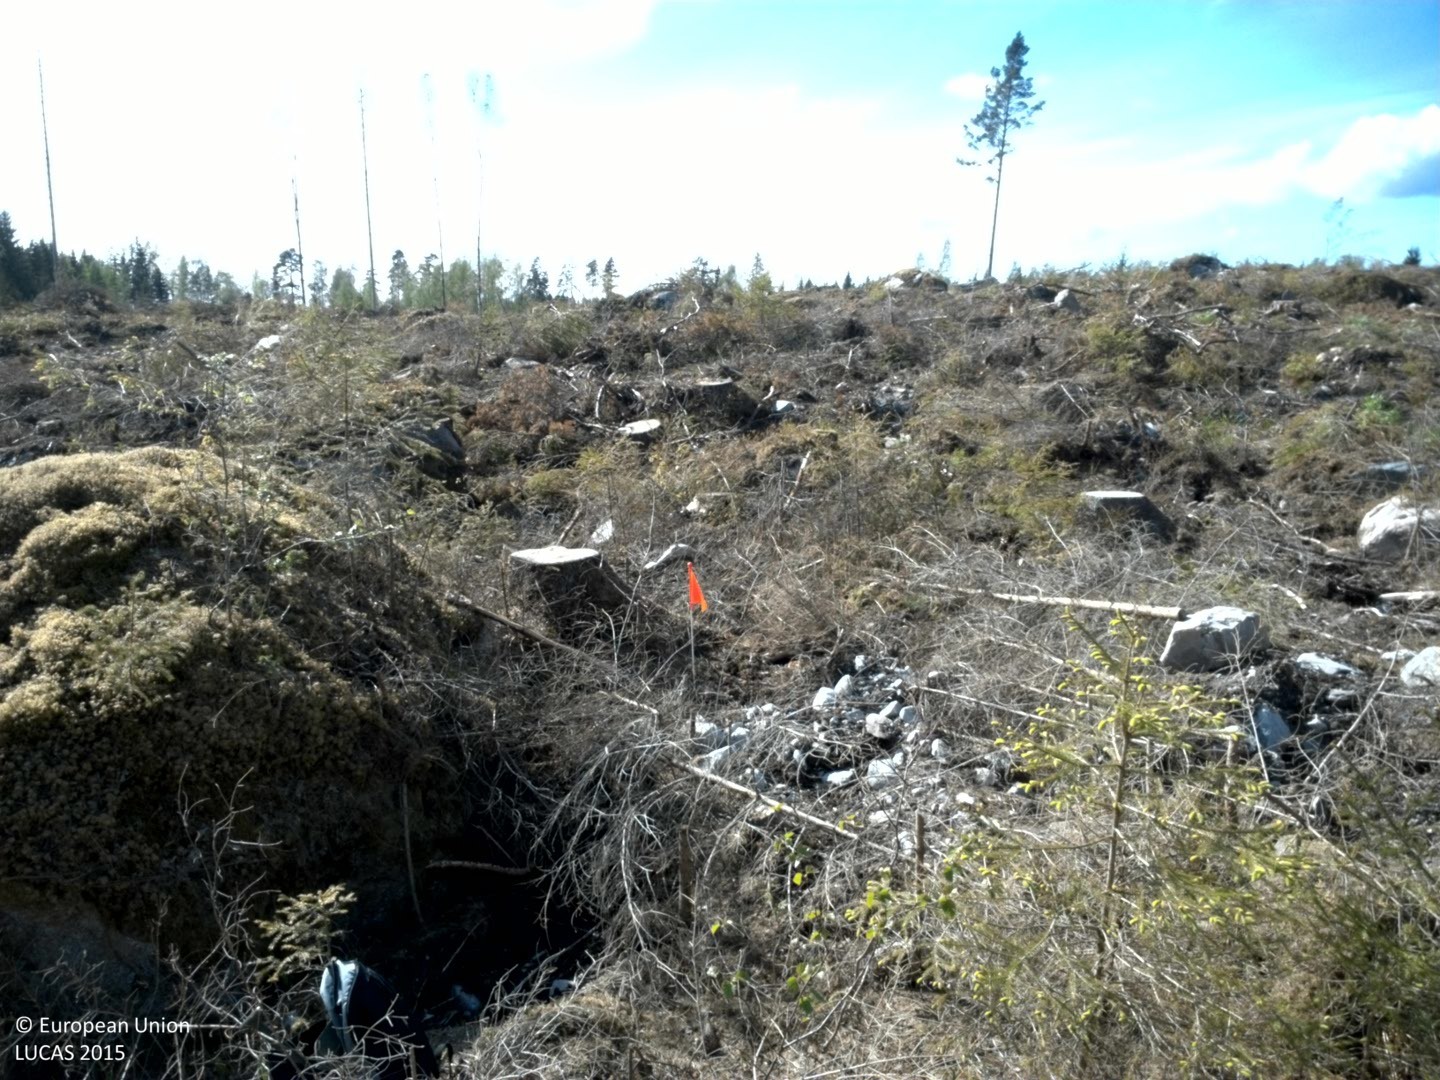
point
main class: Woodland
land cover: Spruce dominated coniferous woodland
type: boreal forest
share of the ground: 10 - 25 %
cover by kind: shrubs 75 %, lichens and mosses 15 %, coniferous forest trees 10 %
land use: Forestry
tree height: < 5 m
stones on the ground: 10 - 25 %
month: May
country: SE
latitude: 59.1023
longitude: 14.4092
